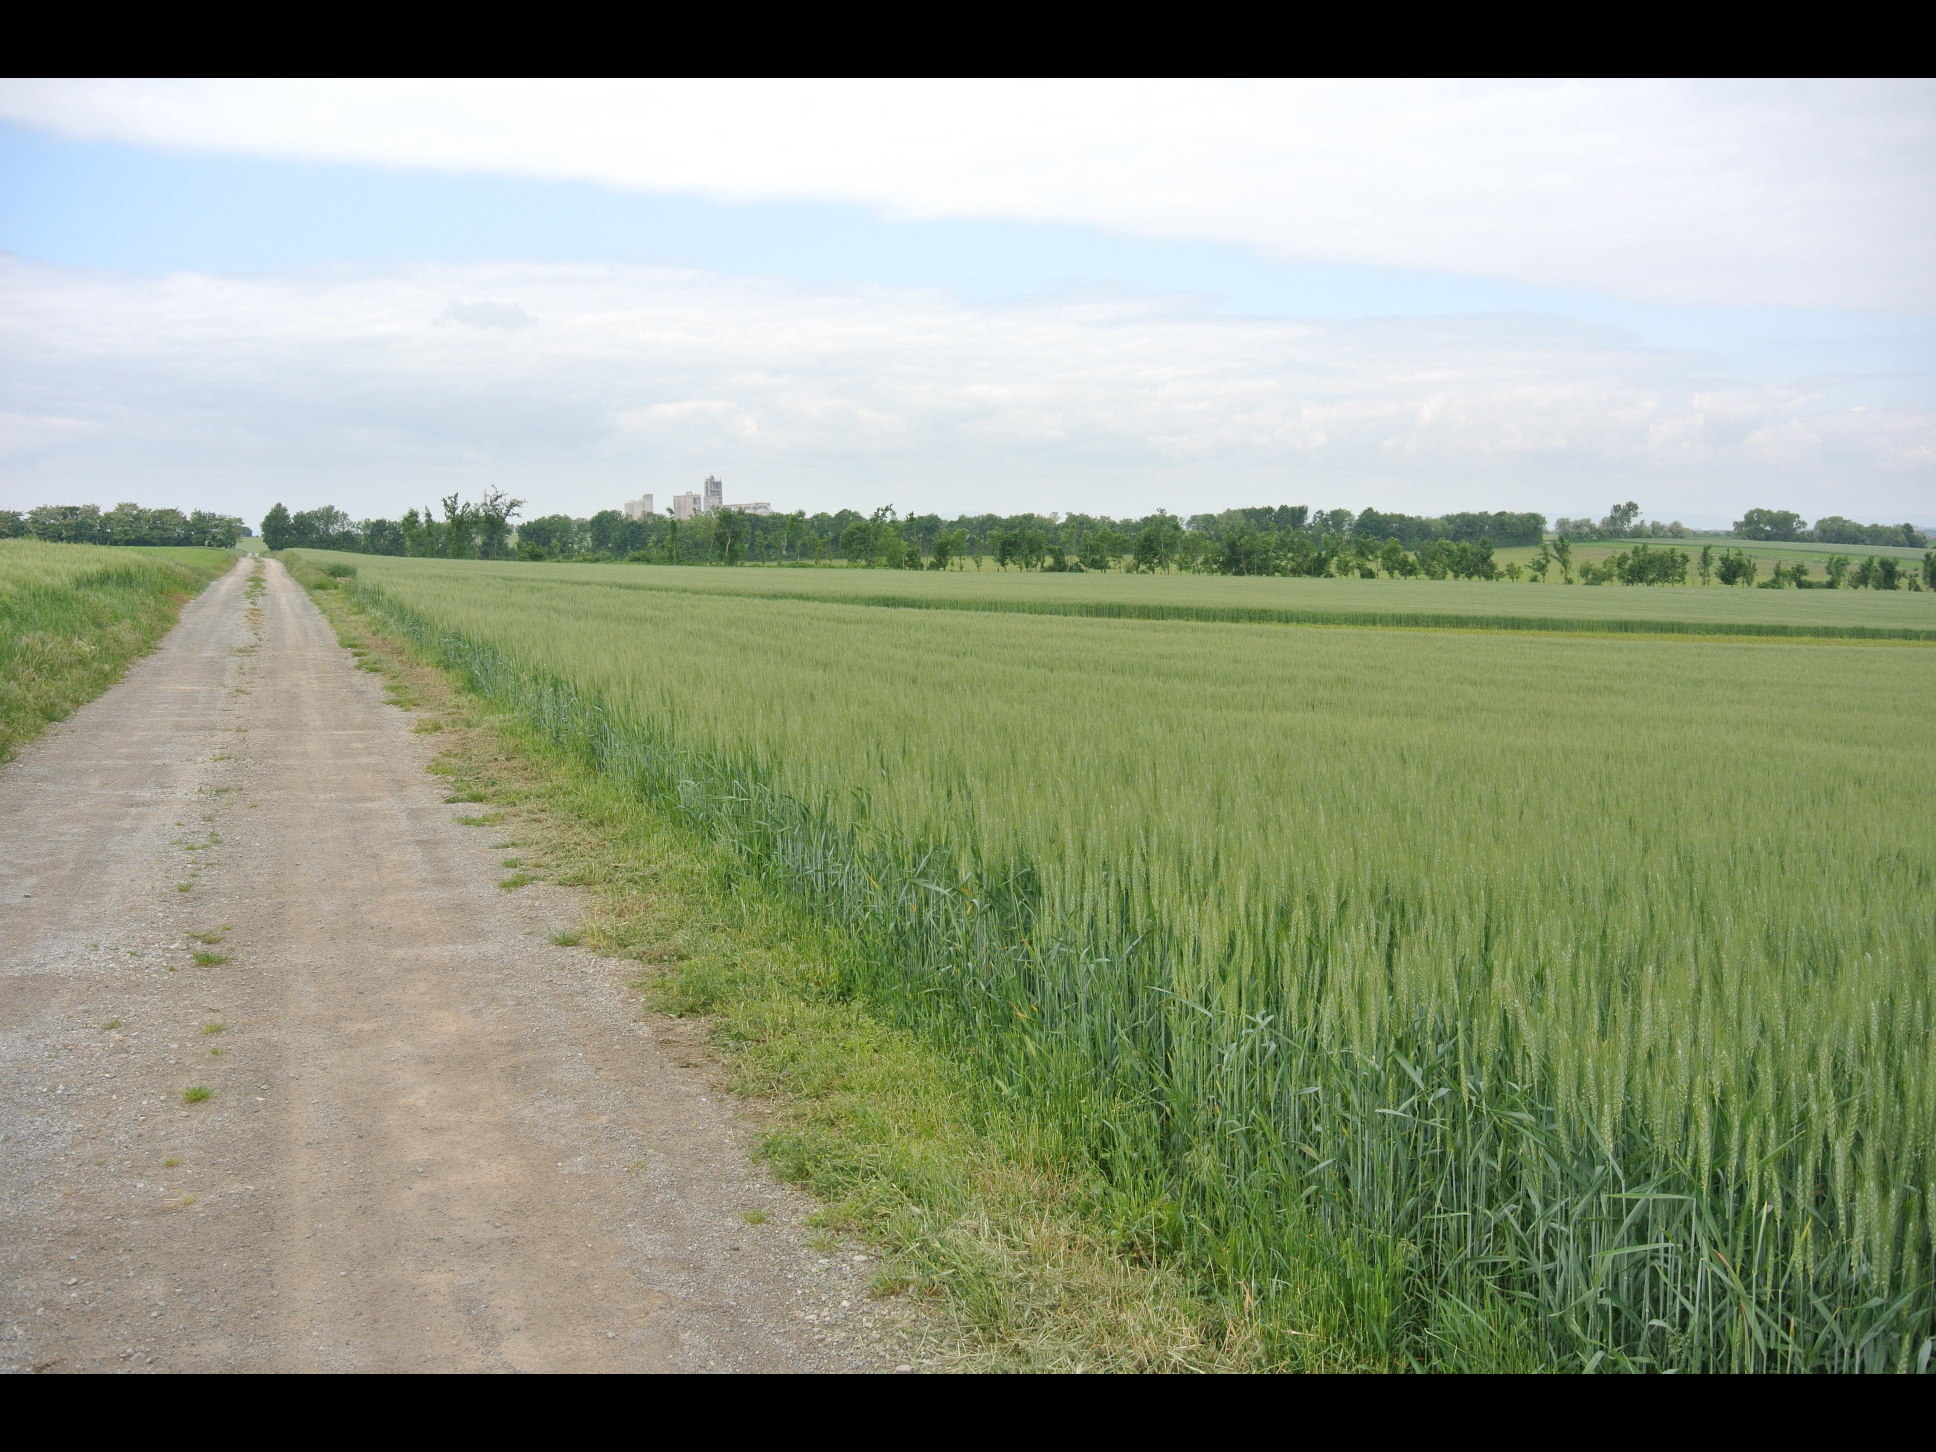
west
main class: Cropland
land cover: Durum wheat
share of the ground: > 75 %
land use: Agriculture (excluding fallow land and kitchen gardens)
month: May
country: AT
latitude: 47.9873
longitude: 16.6382
